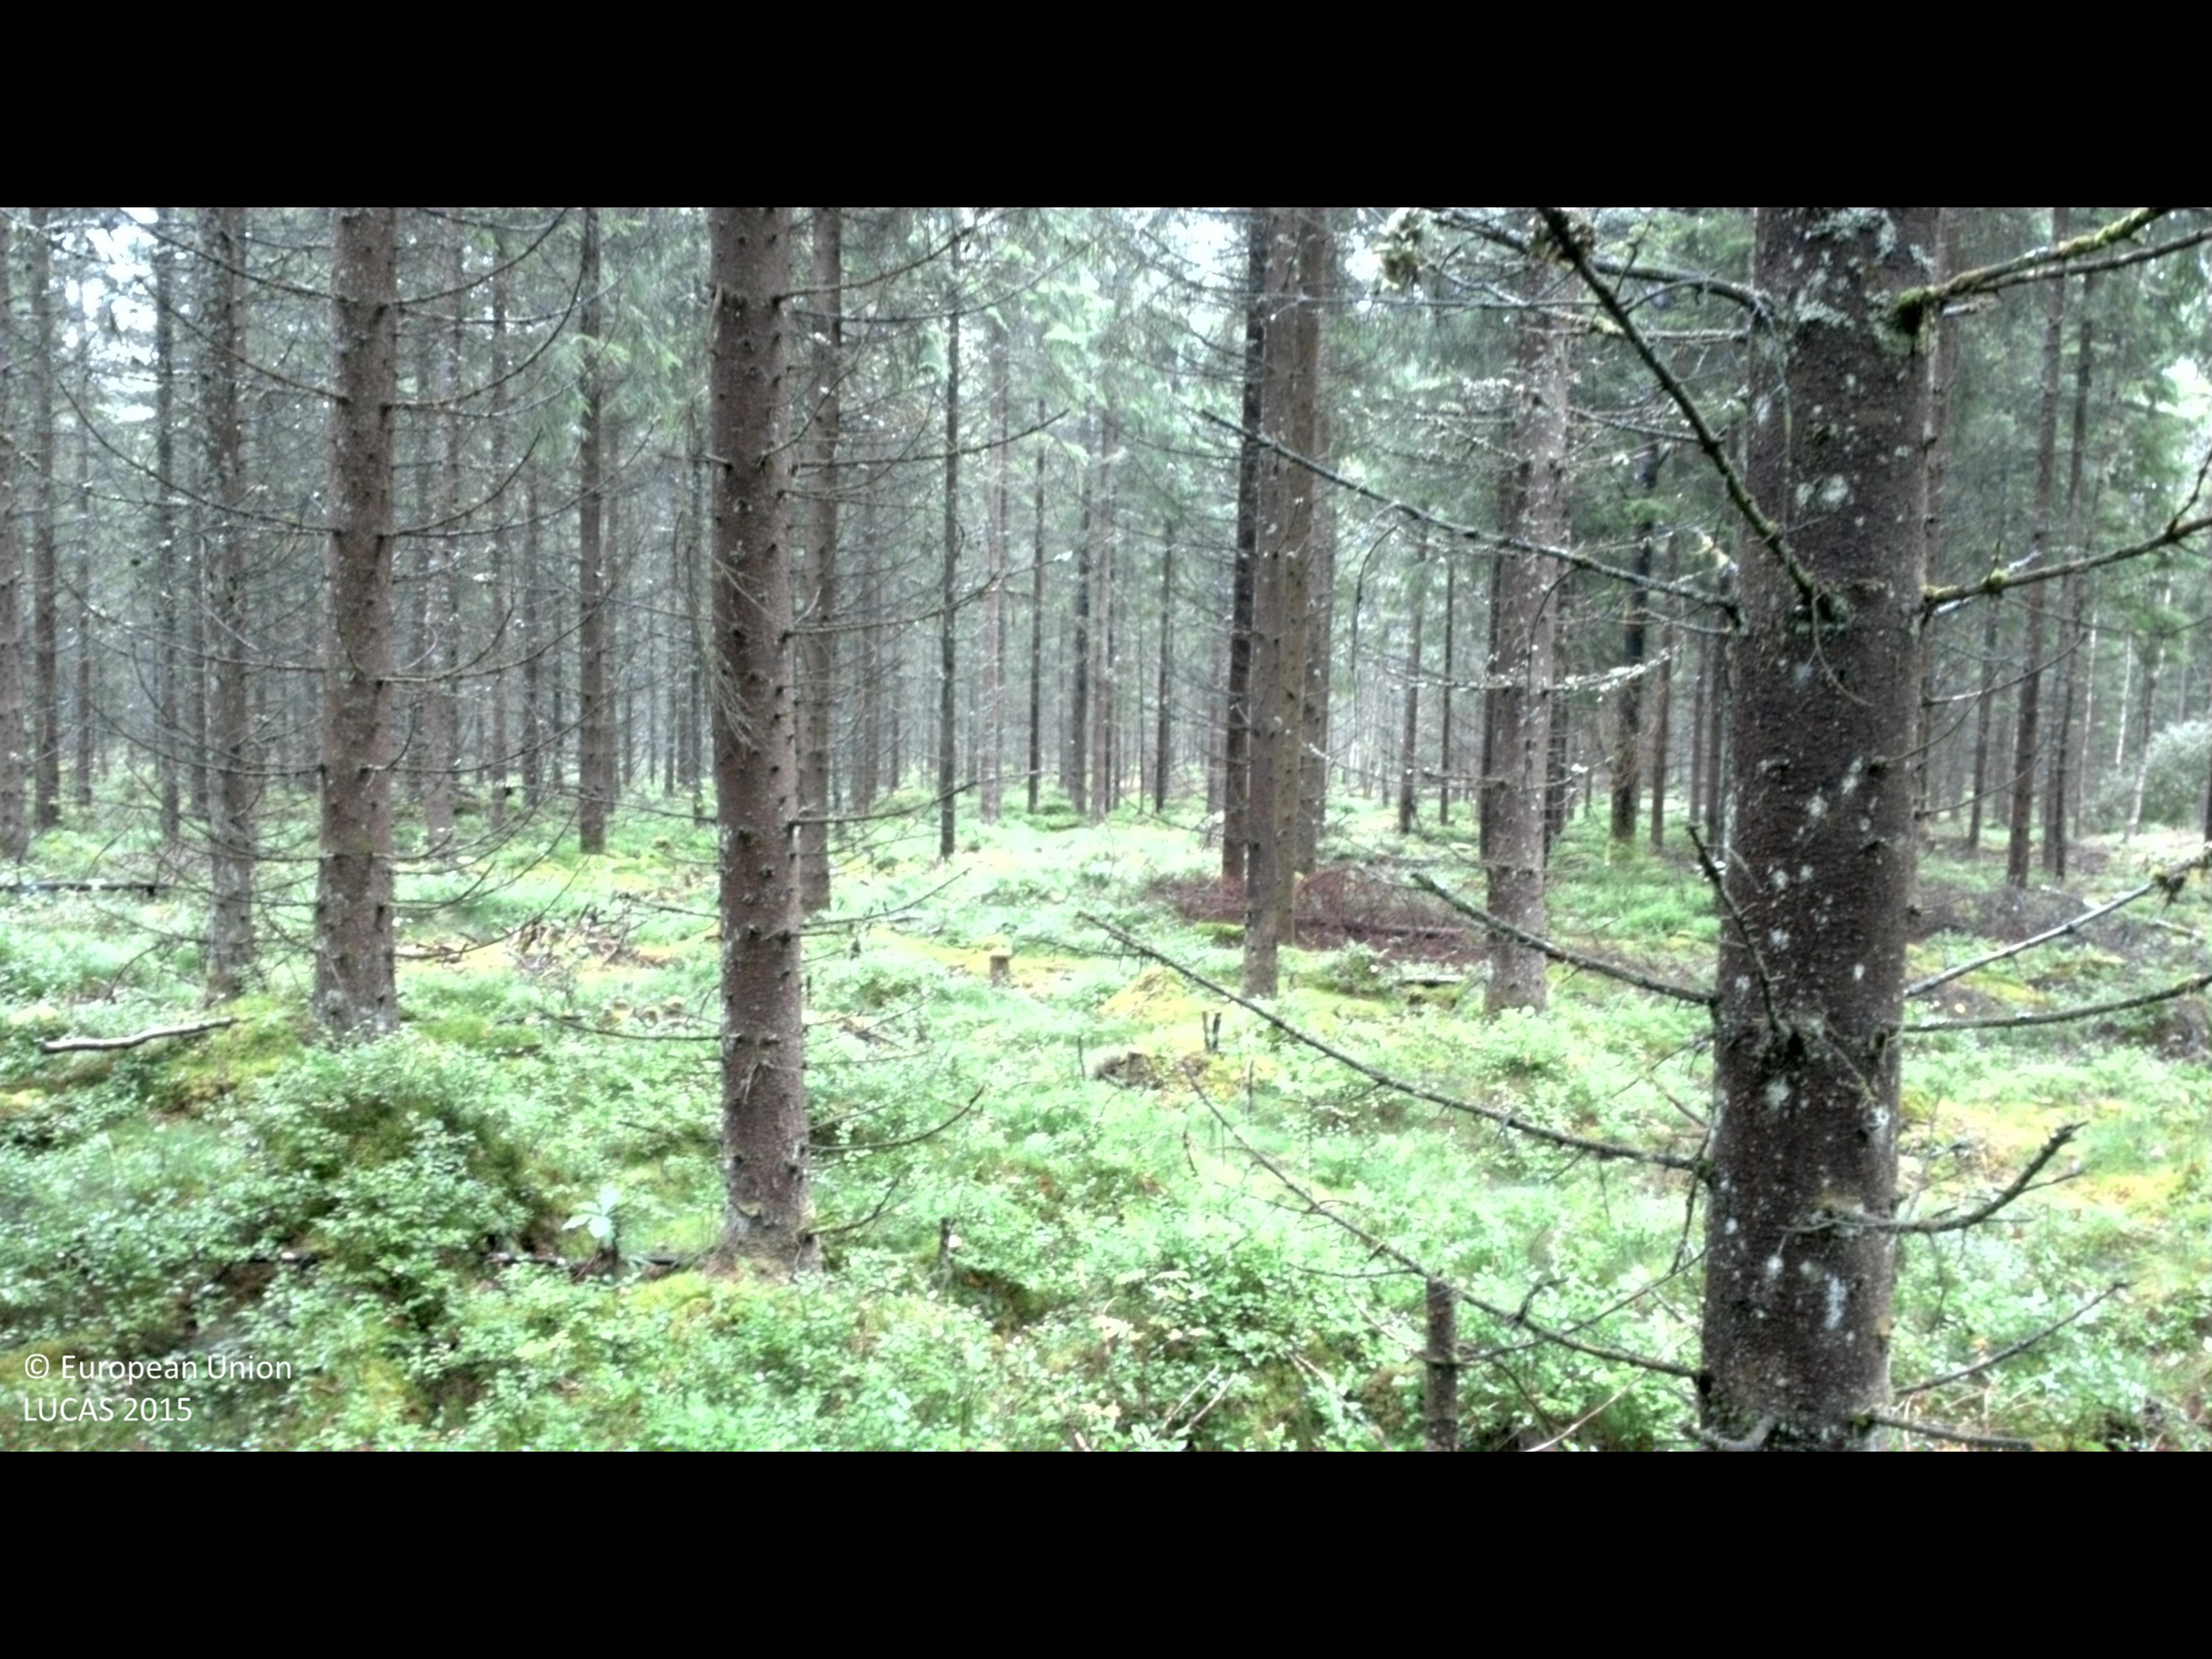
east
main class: Woodland
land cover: Spruce dominated coniferous woodland
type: boreal forest
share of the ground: 50 - 75 %
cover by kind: coniferous forest trees 55 %, shrubs 35 %, broadleaved forest trees 5 %, herbaceous plants 5 %
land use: Forestry
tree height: > 5 m
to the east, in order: Spruce dominated coniferous woodland; Tracks; Spruce dominated coniferous woodland; Tracks; Spruce dominated coniferous woodland; Paved roads, cycling and walking lanes
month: September
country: SE
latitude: 57.3905
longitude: 13.8389
